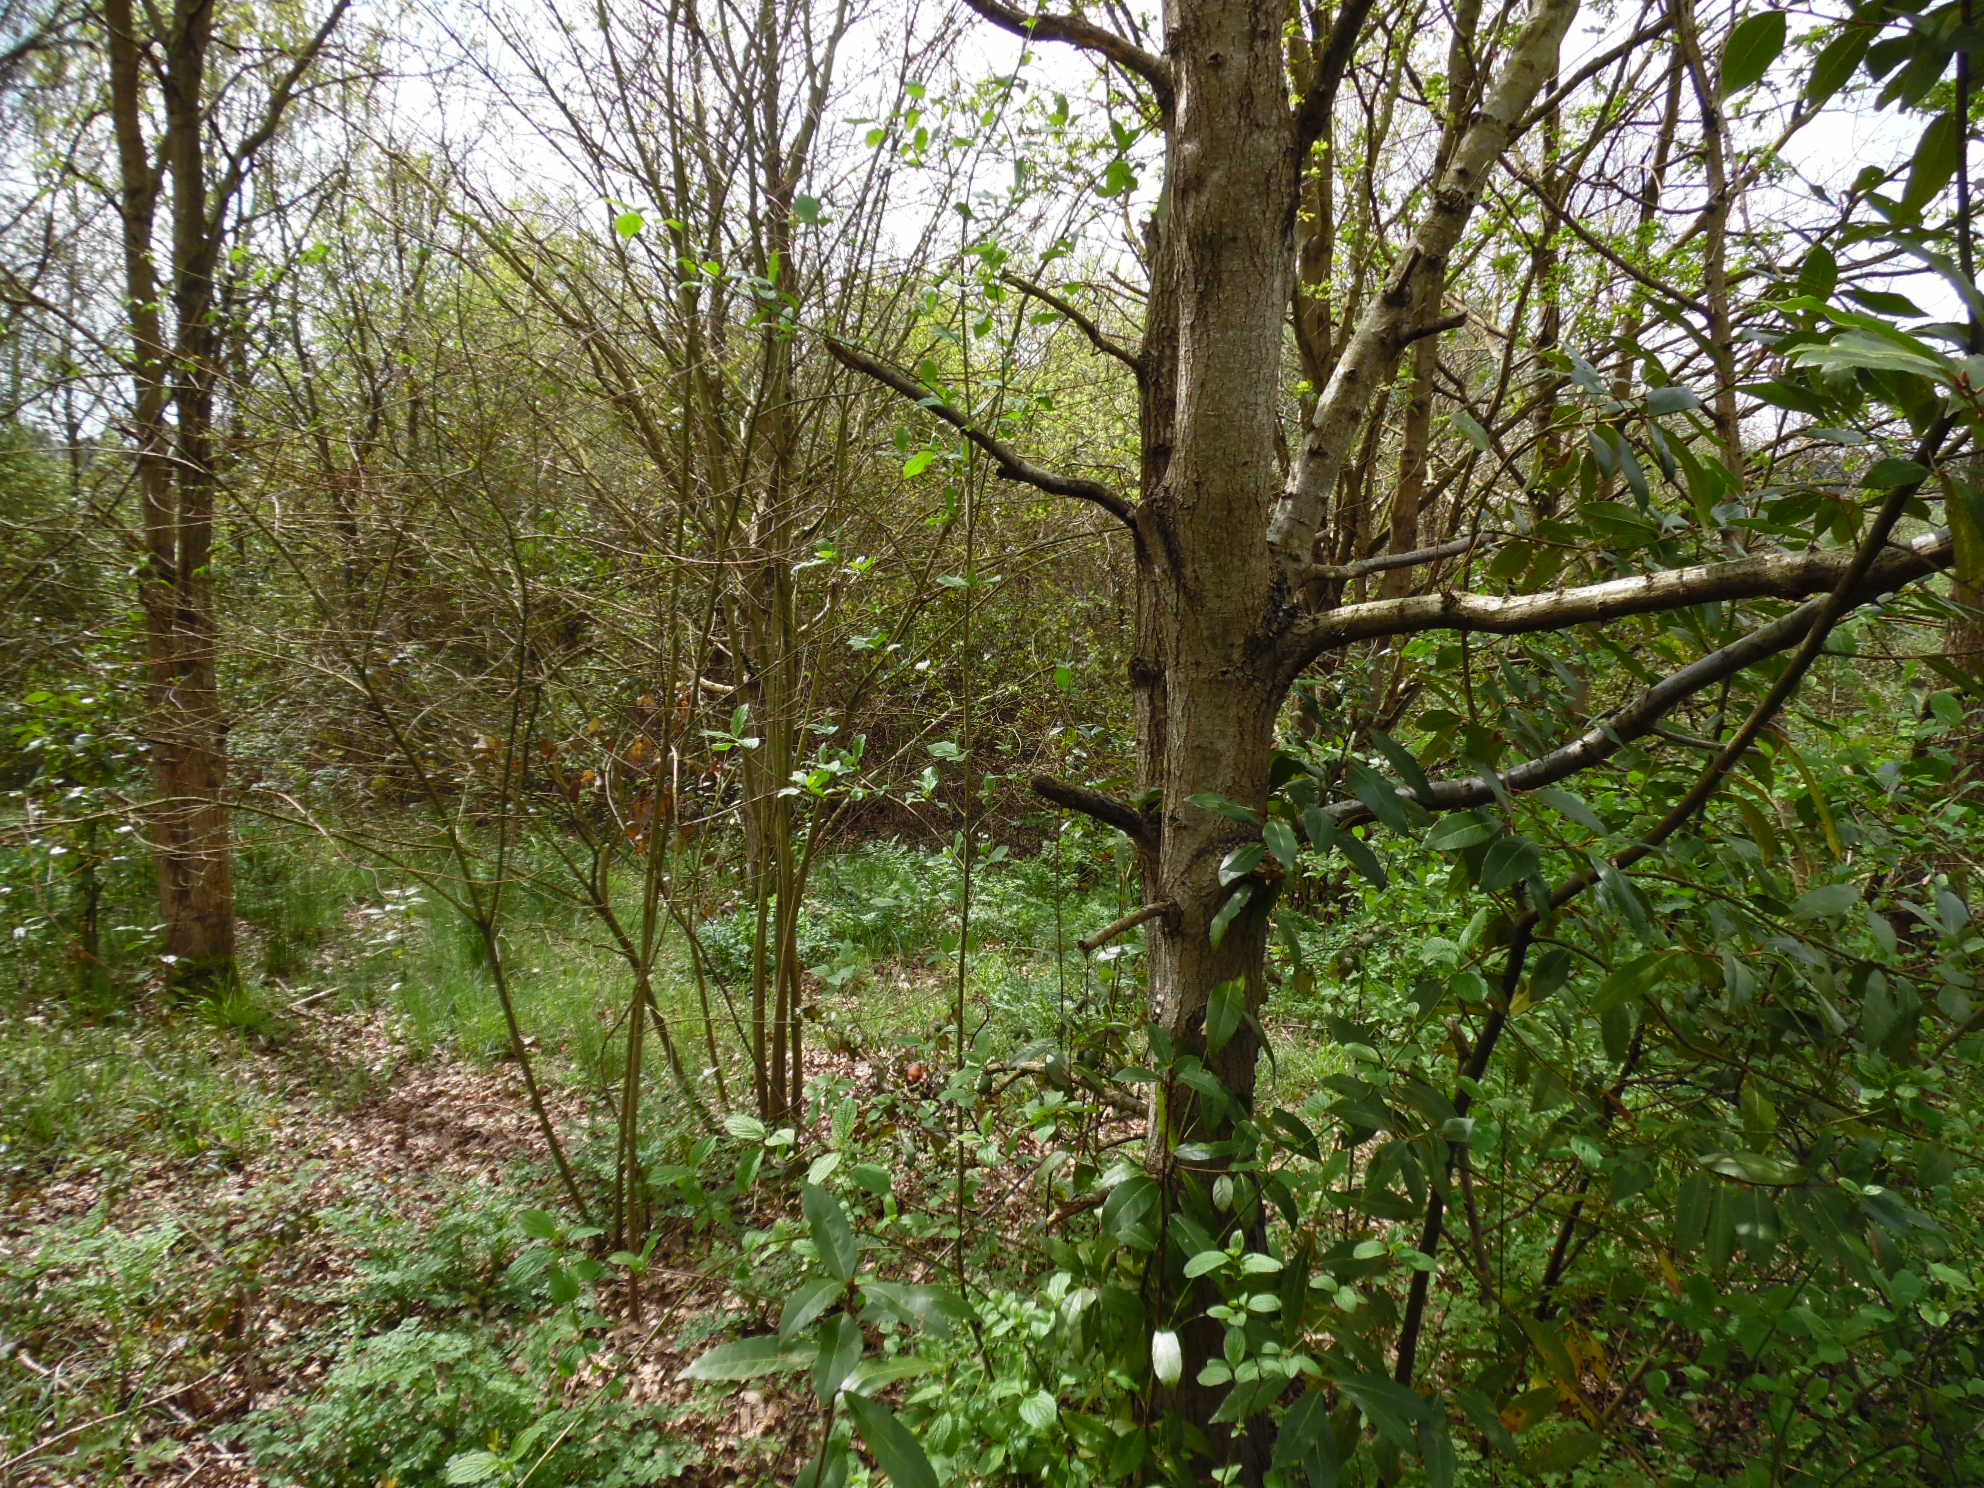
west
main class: Woodland
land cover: Broadleaved woodland
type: floodplain forest
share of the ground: > 75 %
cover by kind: broadleaved forest trees 90 %, shrubs 5 %, herbaceous plants 5 %
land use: Semi-natural and natural areas not in use
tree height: > 5 m
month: April
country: ES
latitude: 43.5245
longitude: -5.8648
